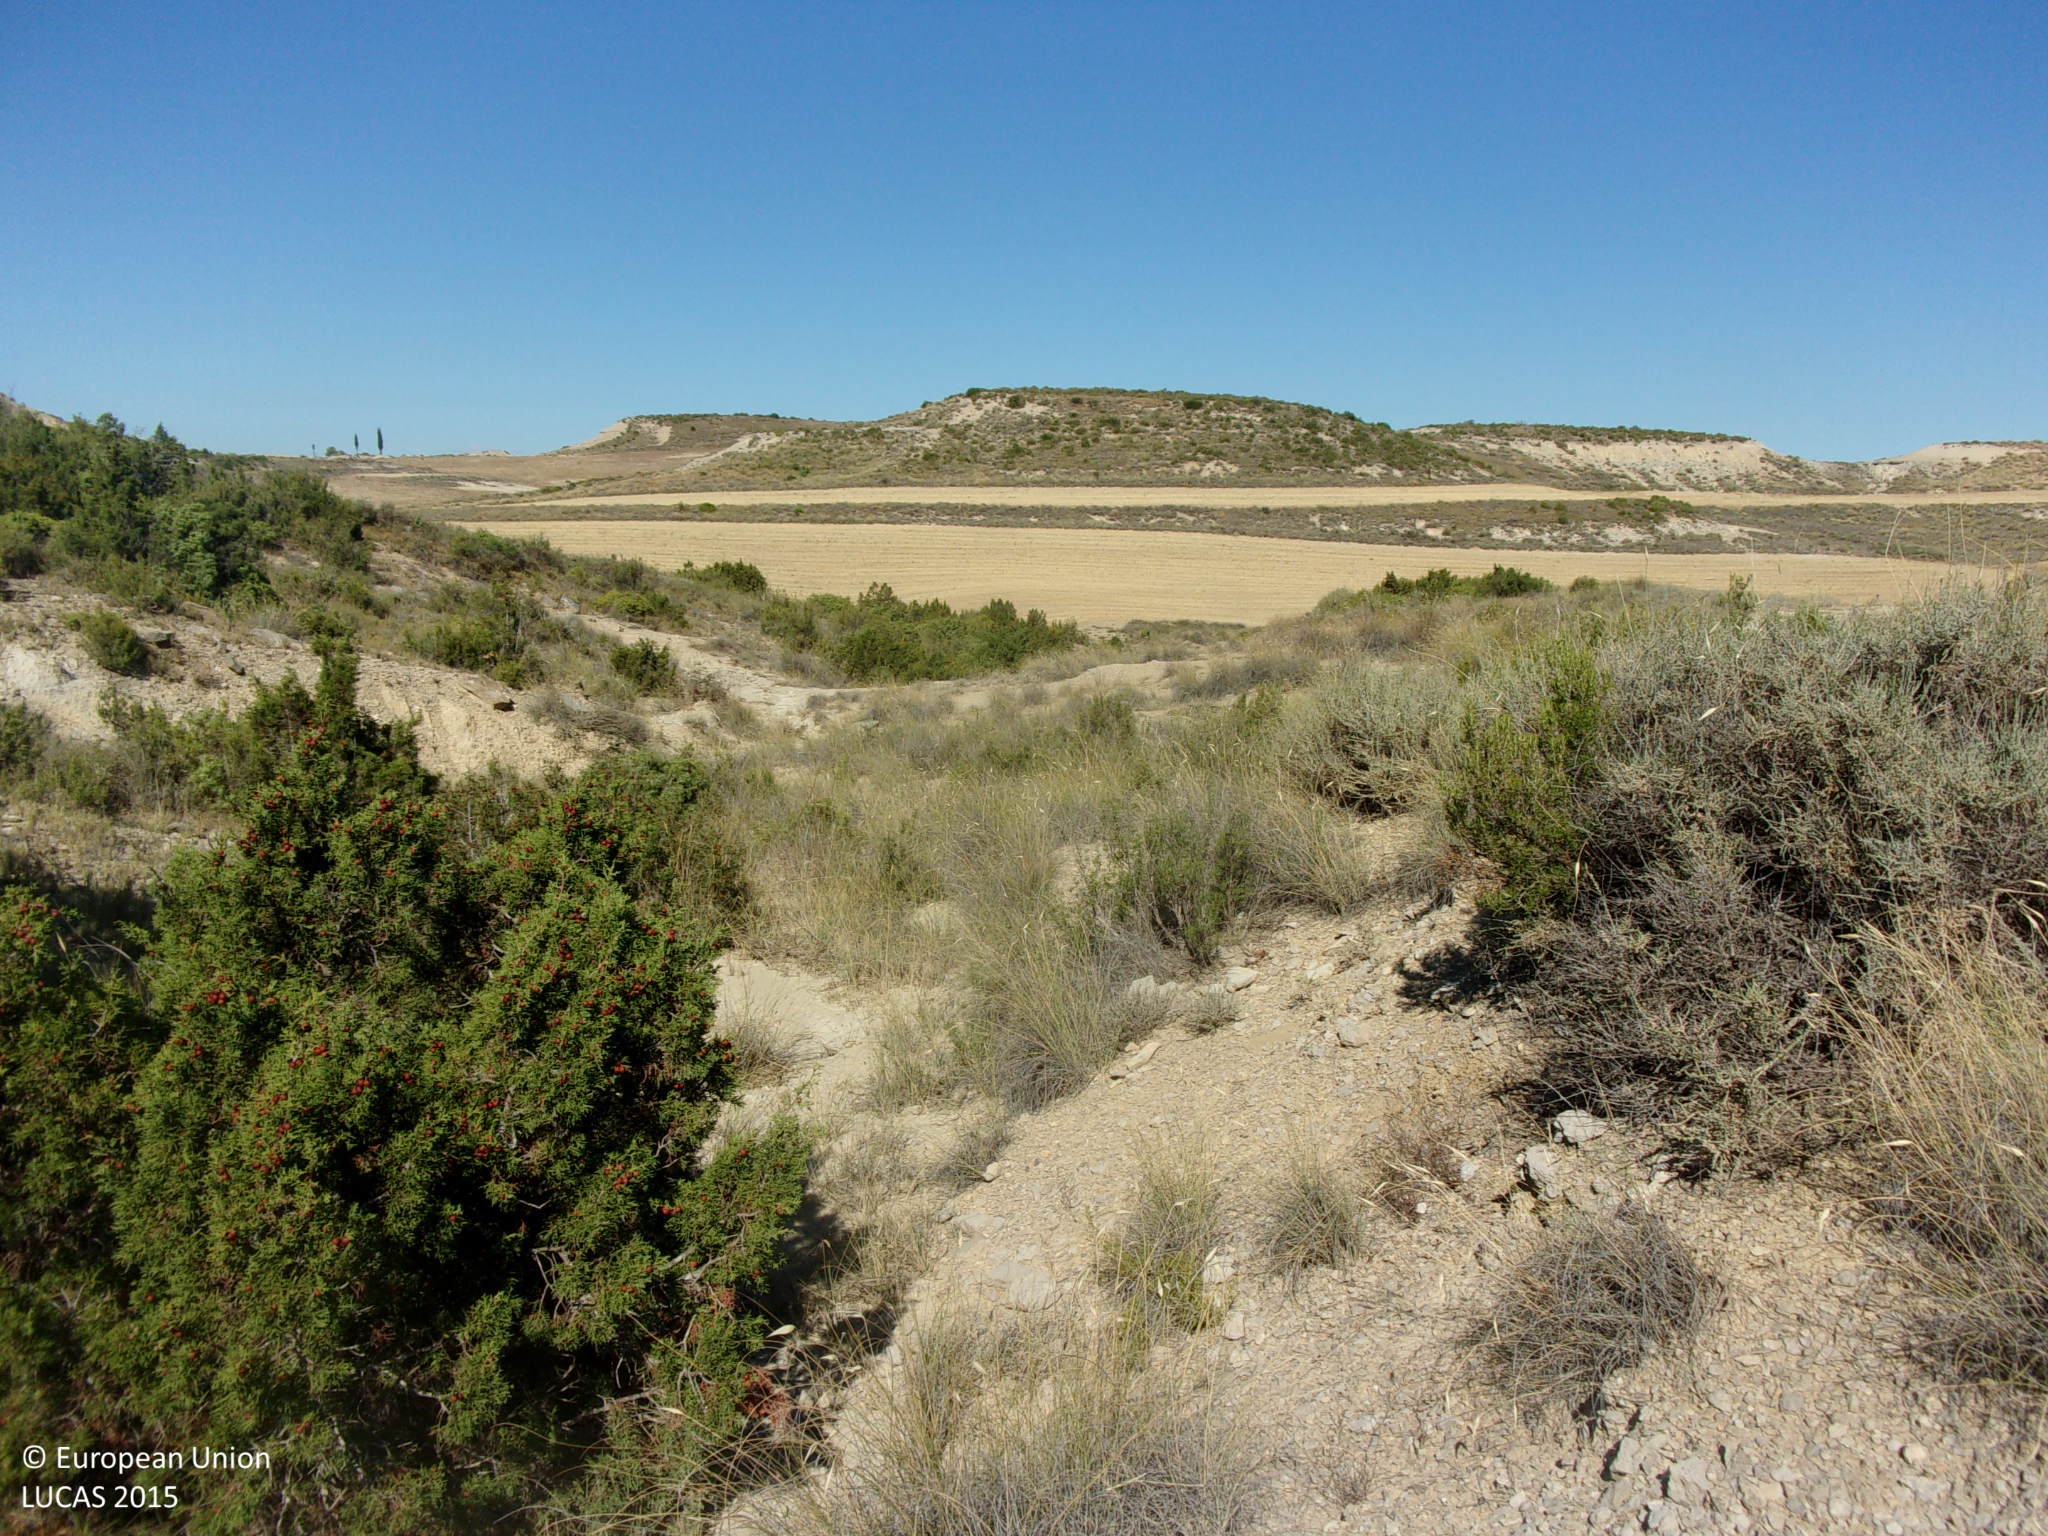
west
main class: Shrubland
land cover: Shrubland without tree cover
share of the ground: > 75 %
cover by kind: shrubs 75 %, unconsolidated bare surface 25 %
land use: Semi-natural and natural areas not in use
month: July
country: ES
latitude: 42.0646
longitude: -1.0606
